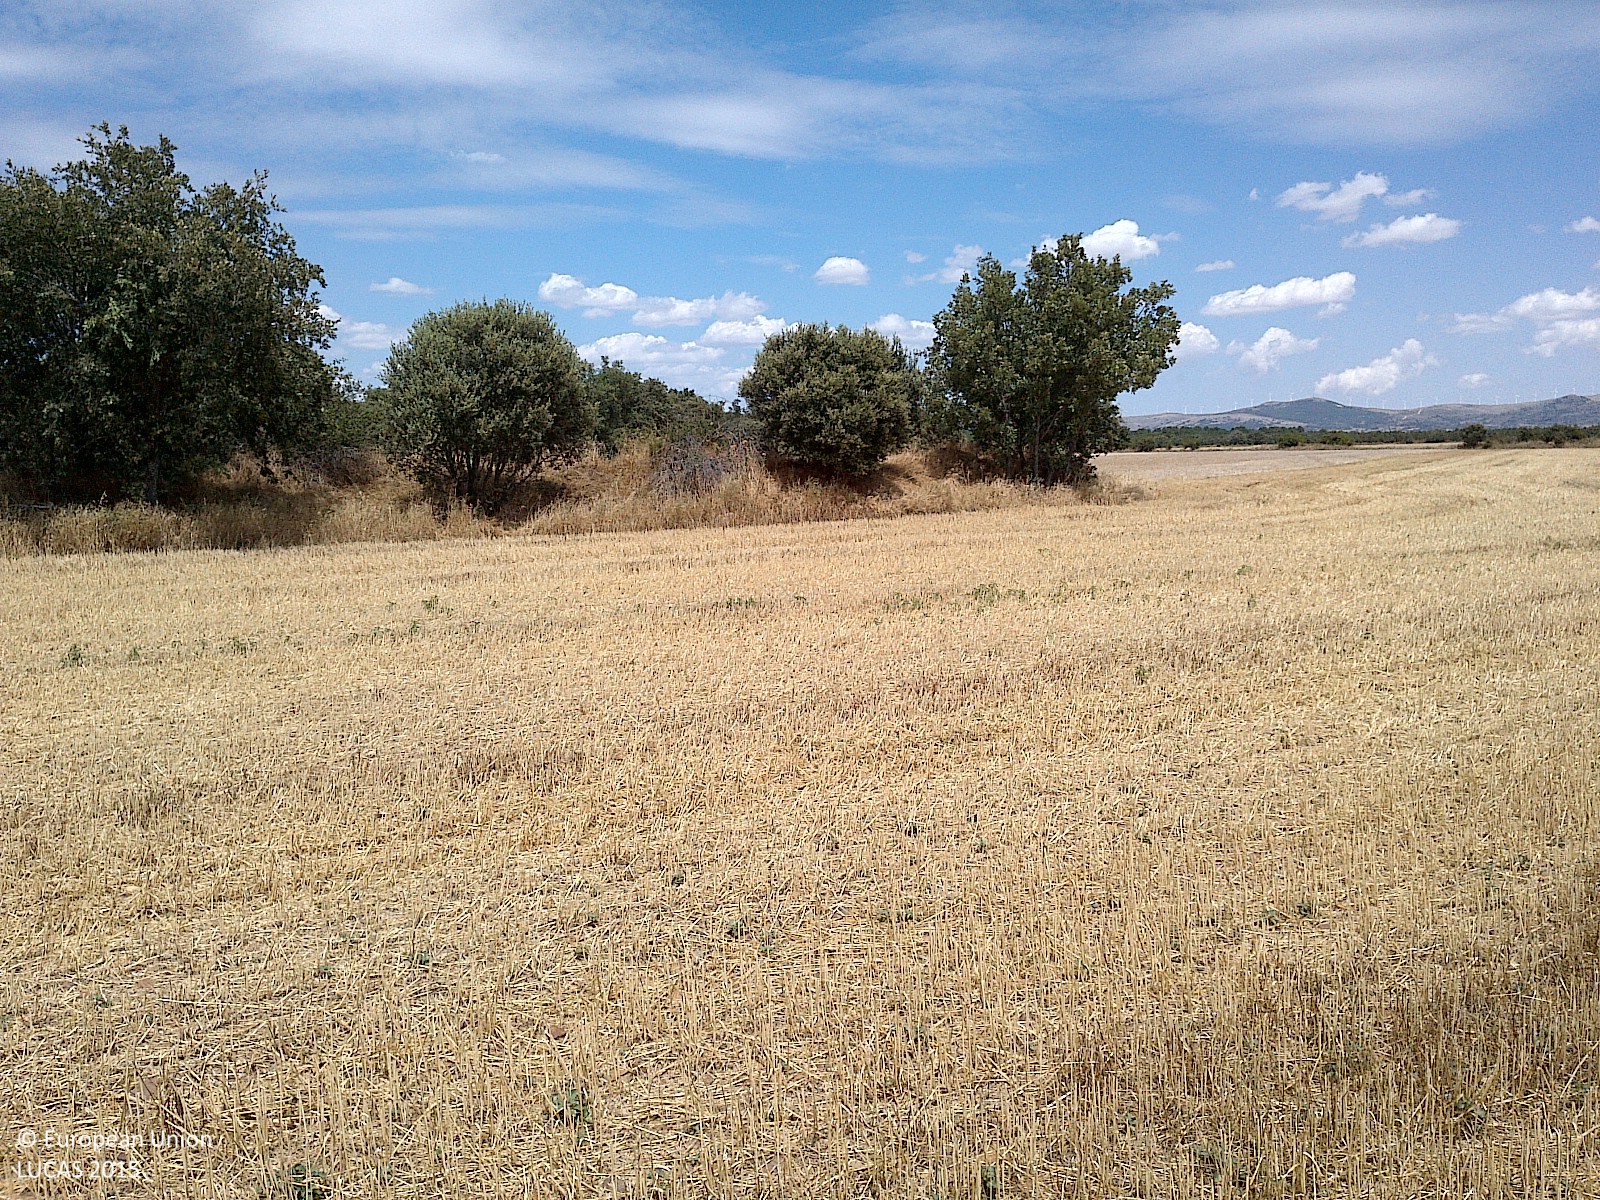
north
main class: Cropland
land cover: Common wheat
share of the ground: < 10 %
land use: Agriculture (excluding fallow land and kitchen gardens)
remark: Harvested field
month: July
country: ES
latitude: 41.6756
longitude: -2.0566
